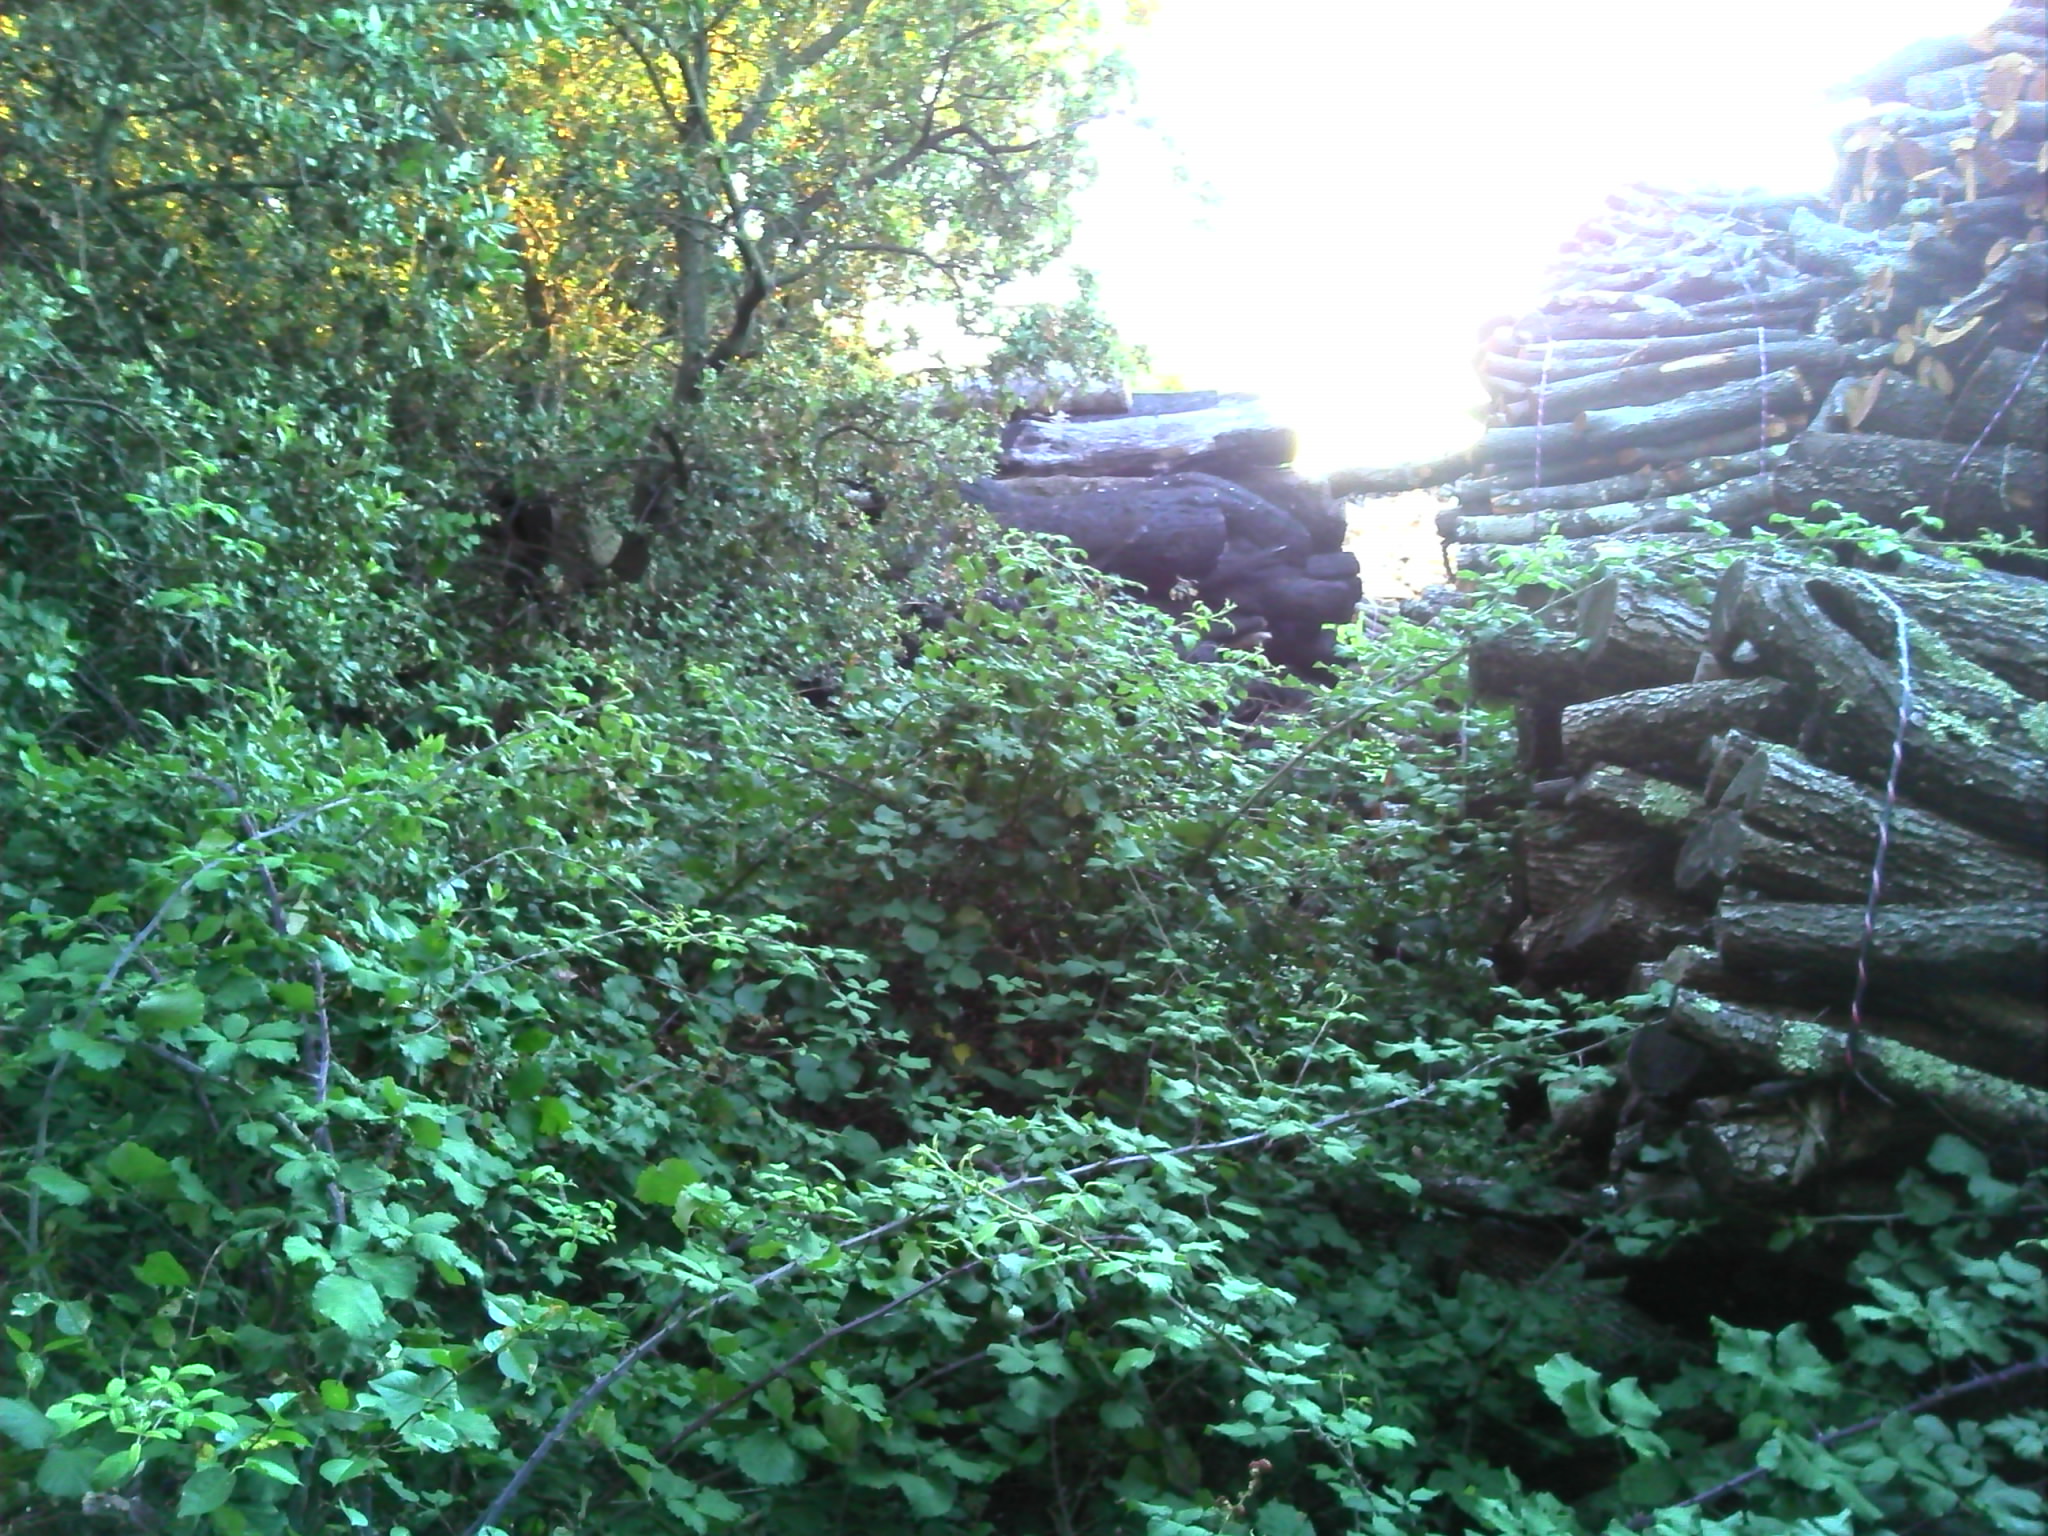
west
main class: Woodland
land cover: Broadleaved woodland
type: broadleaved evergreen forest
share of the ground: > 75 %
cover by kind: broadleaved forest trees 70 %, herbaceous plants 15 %, consolidated bare surface 15 %
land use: Forestry
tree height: > 5 m
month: August
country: FR
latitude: 43.9601
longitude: 4.6621
